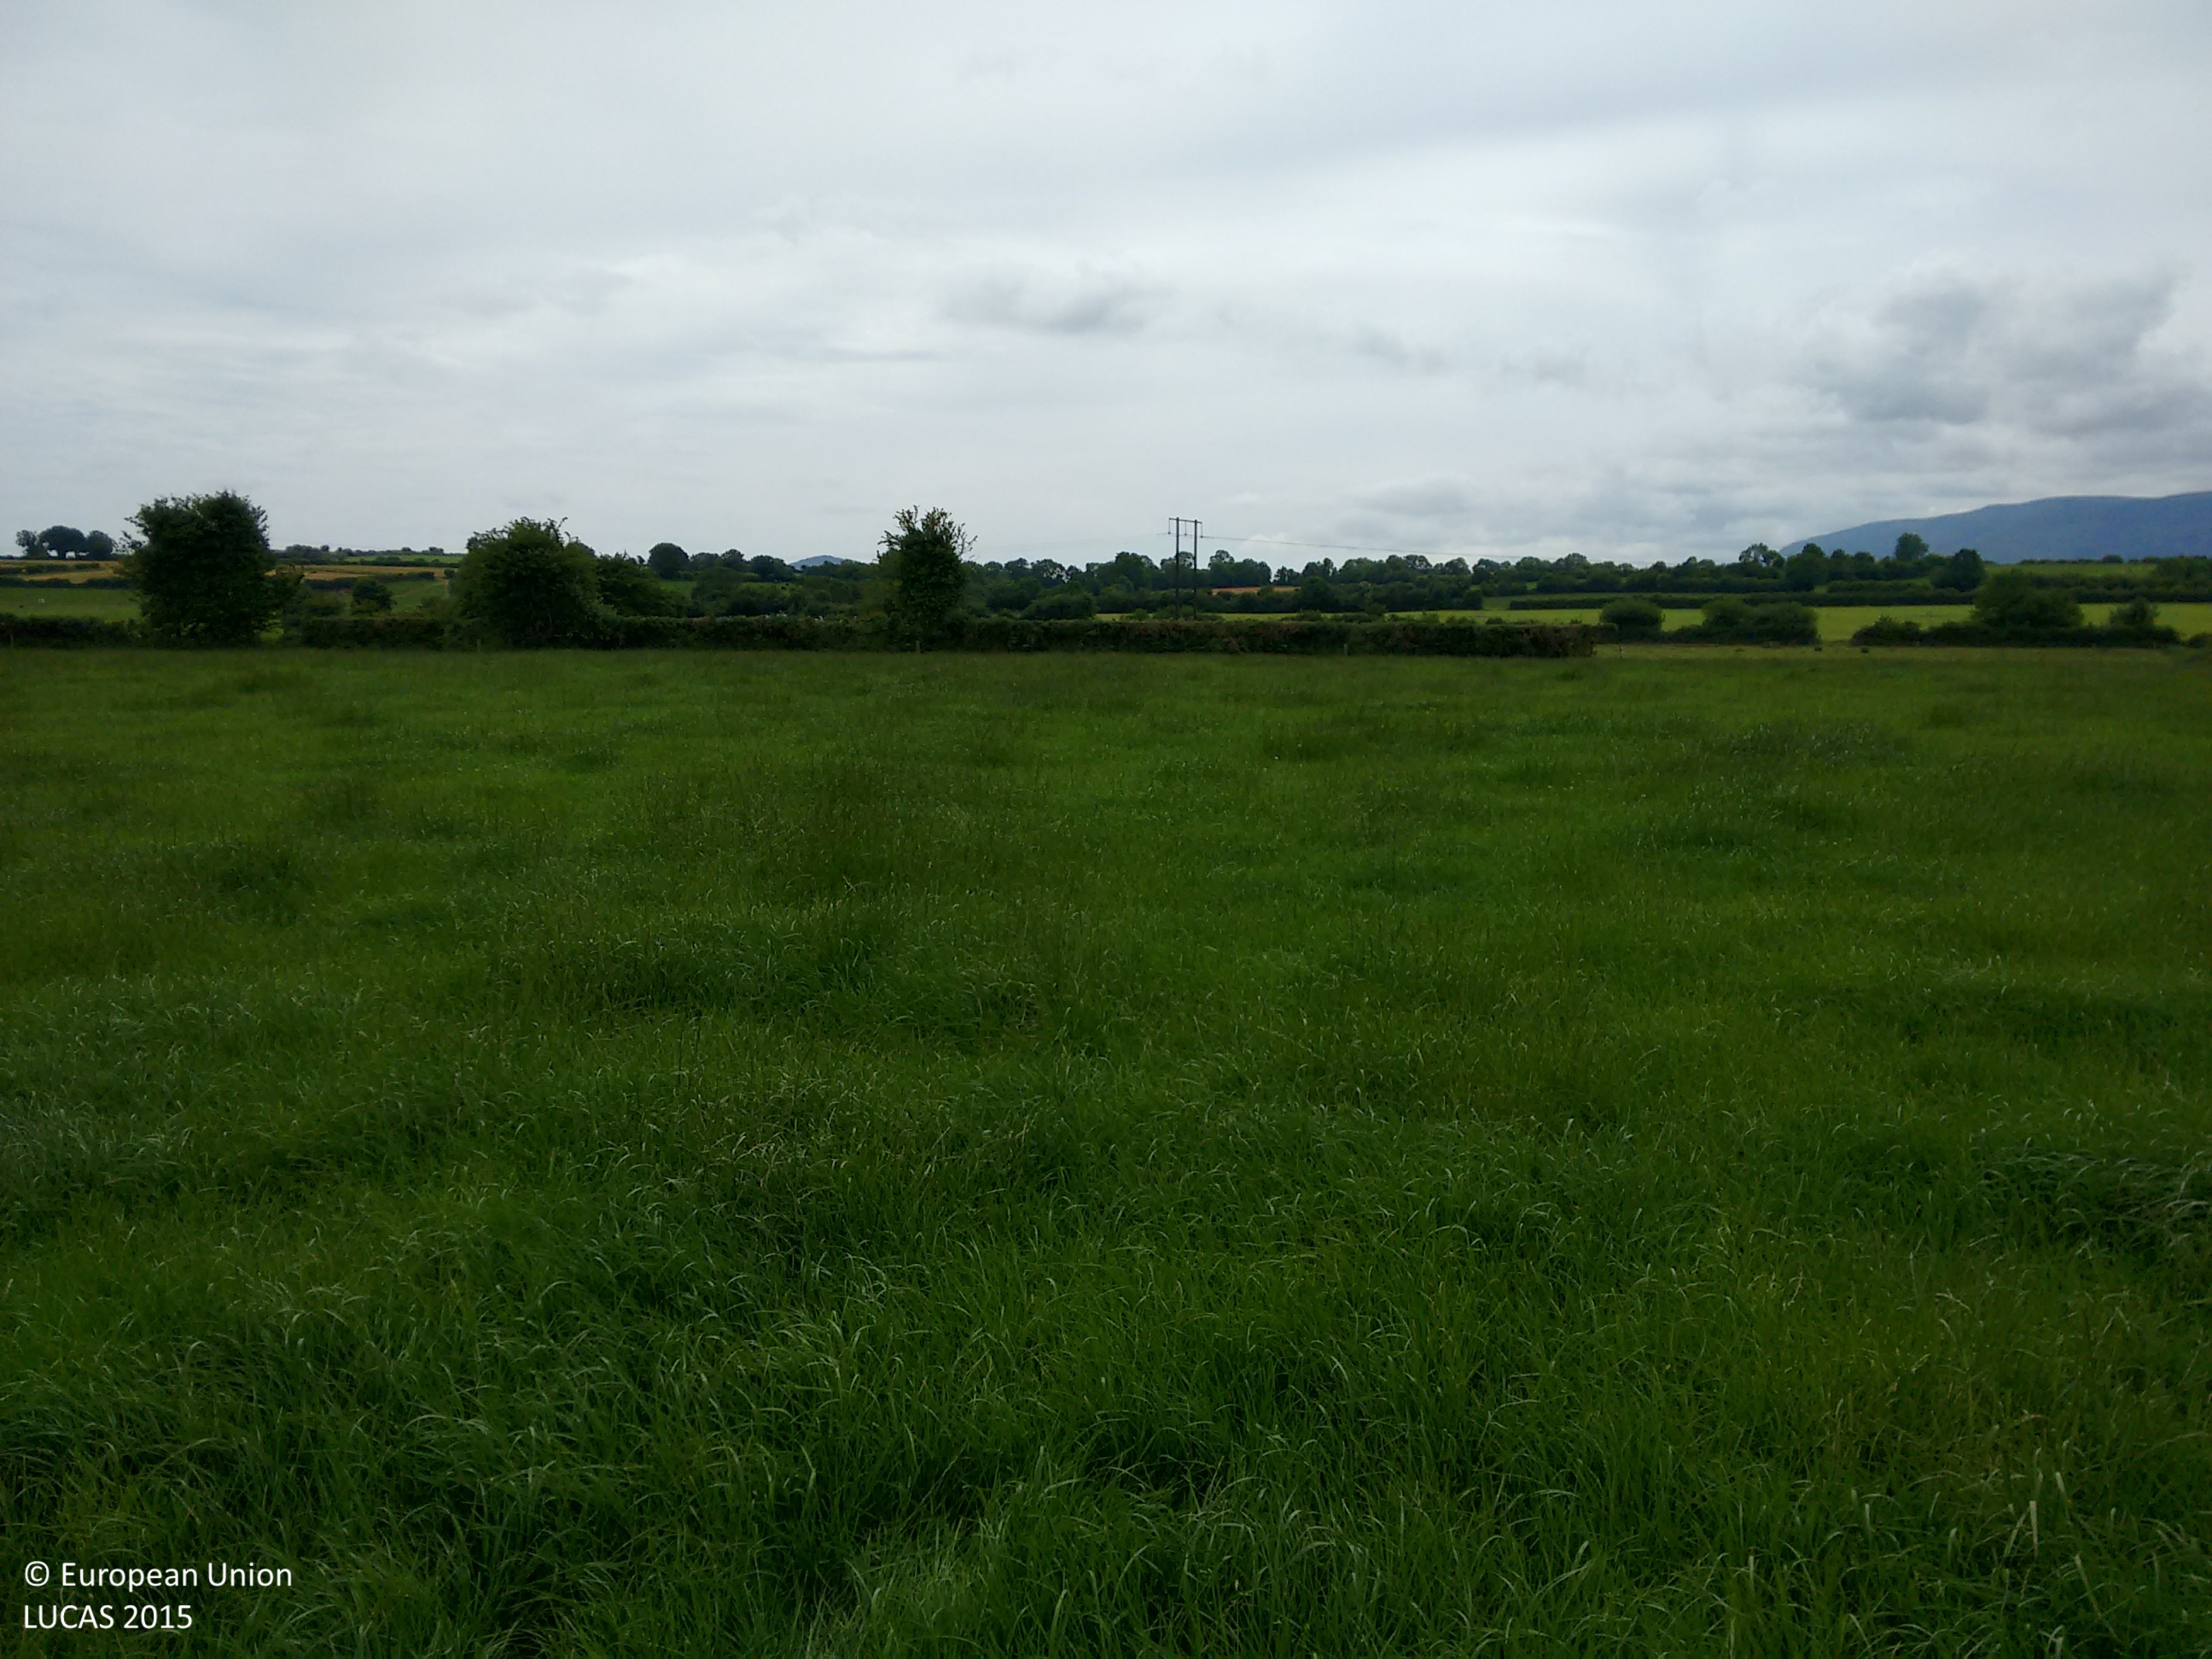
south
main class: Grassland
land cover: Grassland without tree/shrub cover
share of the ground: > 75 %
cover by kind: herbaceous plants 100 %
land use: Agriculture (excluding fallow land and kitchen gardens)
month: June
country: IE
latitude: 52.3219
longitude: -7.4553
